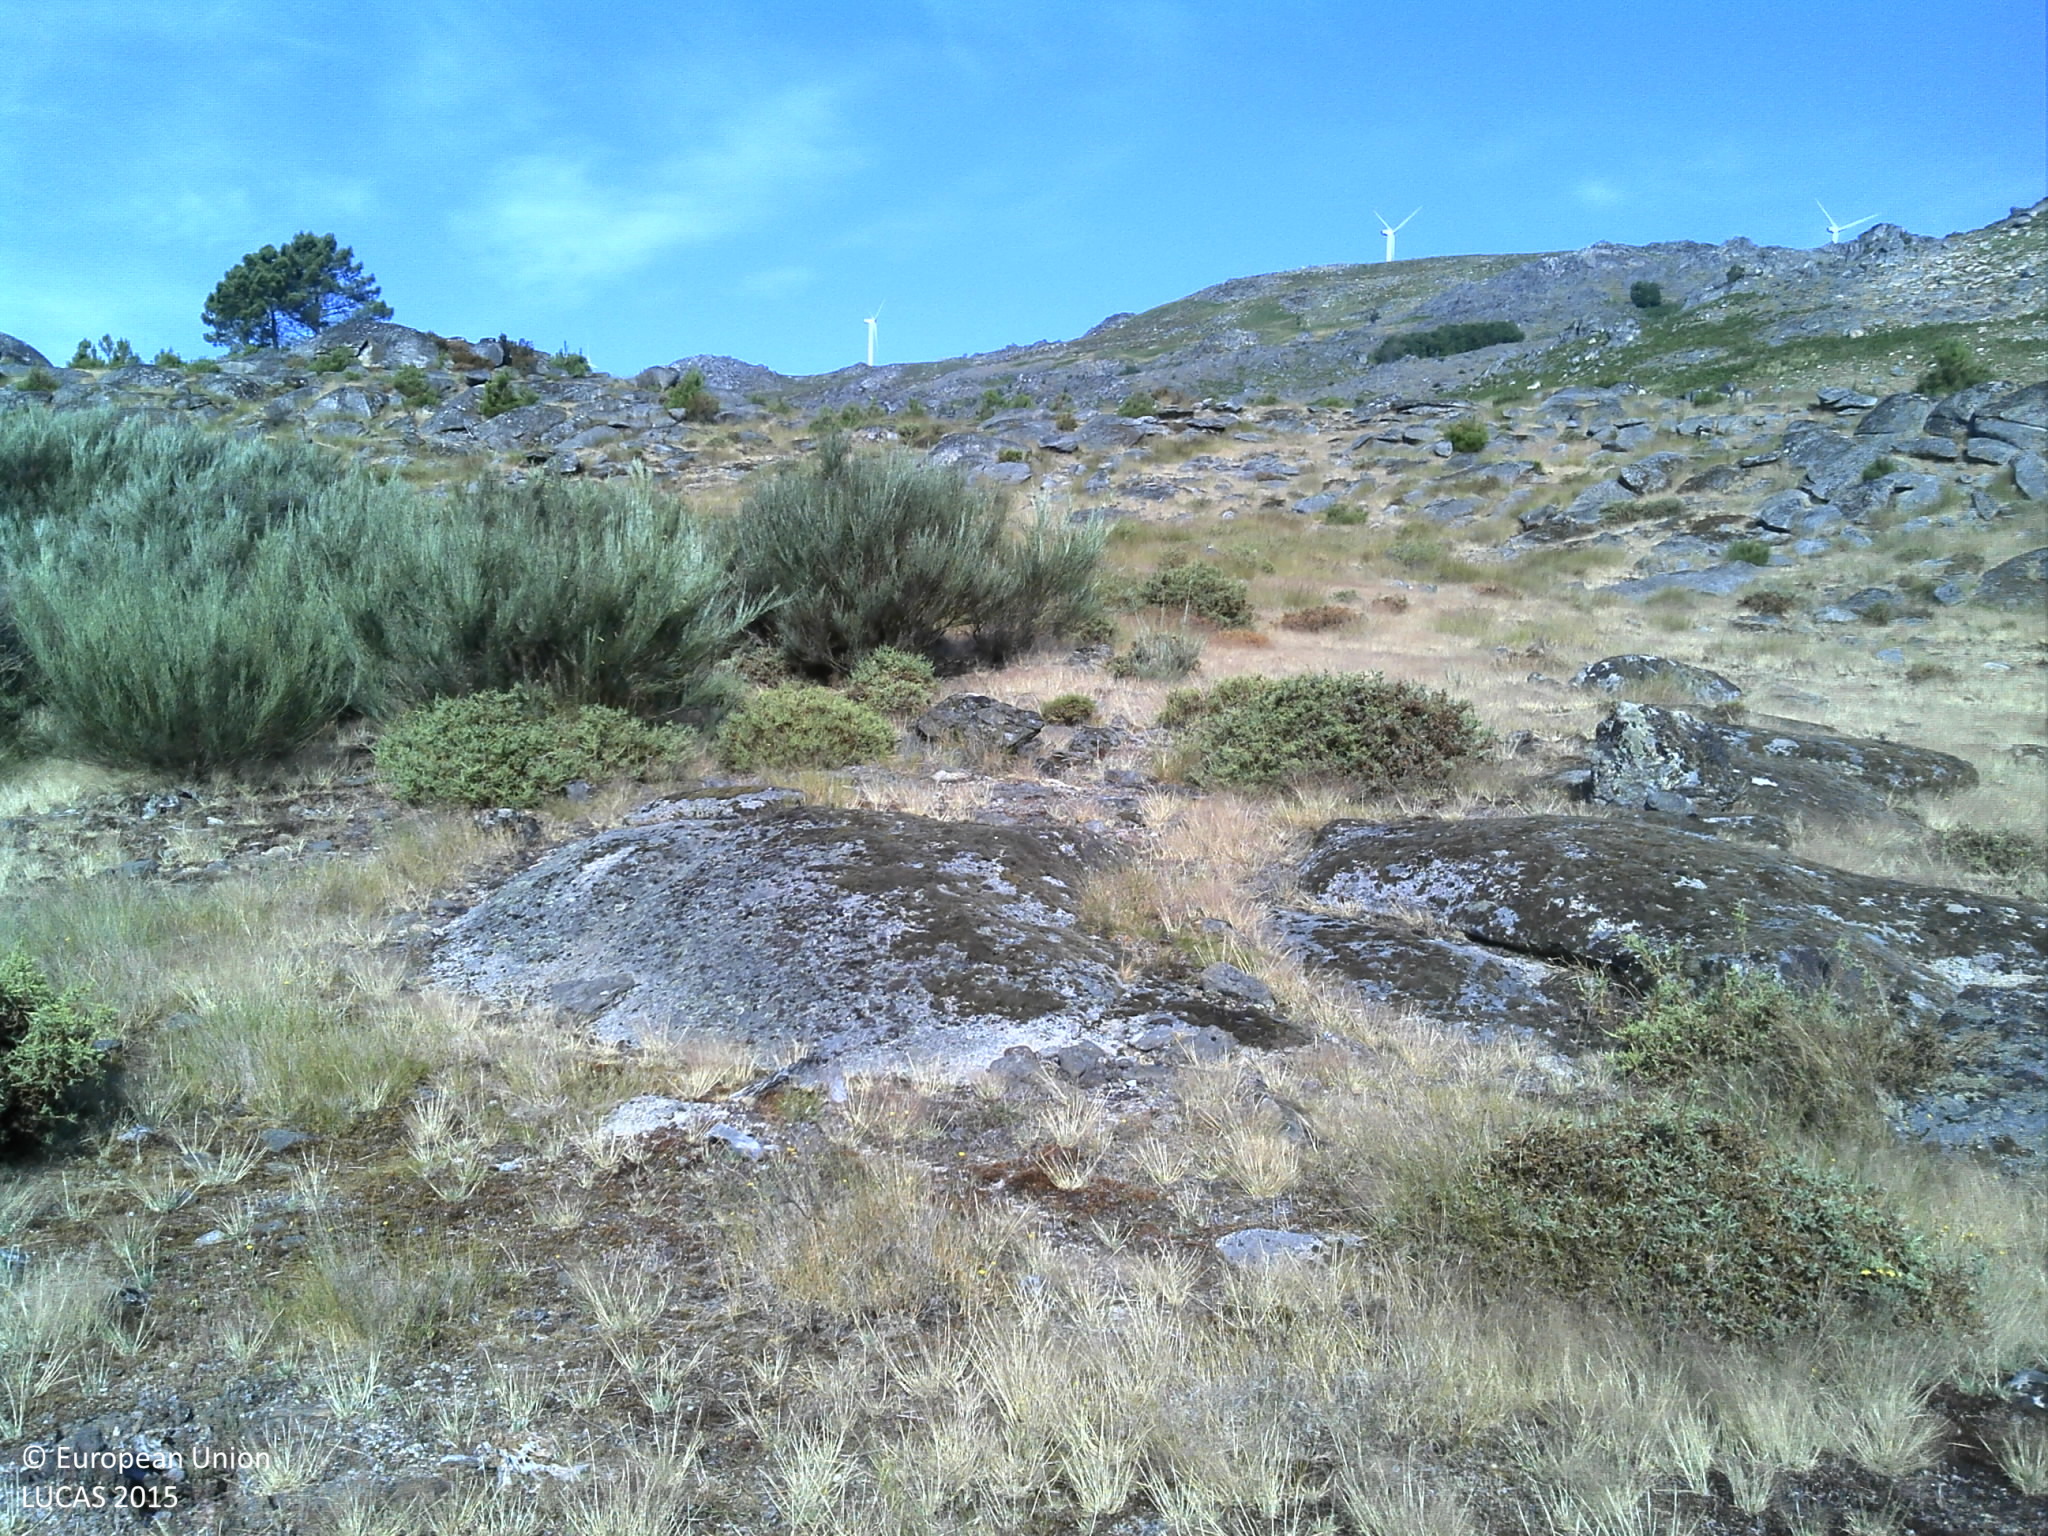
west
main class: Shrubland
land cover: Shrubland without tree cover
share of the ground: 50 - 75 %
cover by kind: shrubs 75 %, herbaceous plants 10 %, unconsolidated bare surface 10 %, consolidated bare surface 5 %
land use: Agriculture (excluding fallow land and kitchen gardens)
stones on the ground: 10 - 25 %
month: July
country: PT
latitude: 41.3898
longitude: -7.7234
